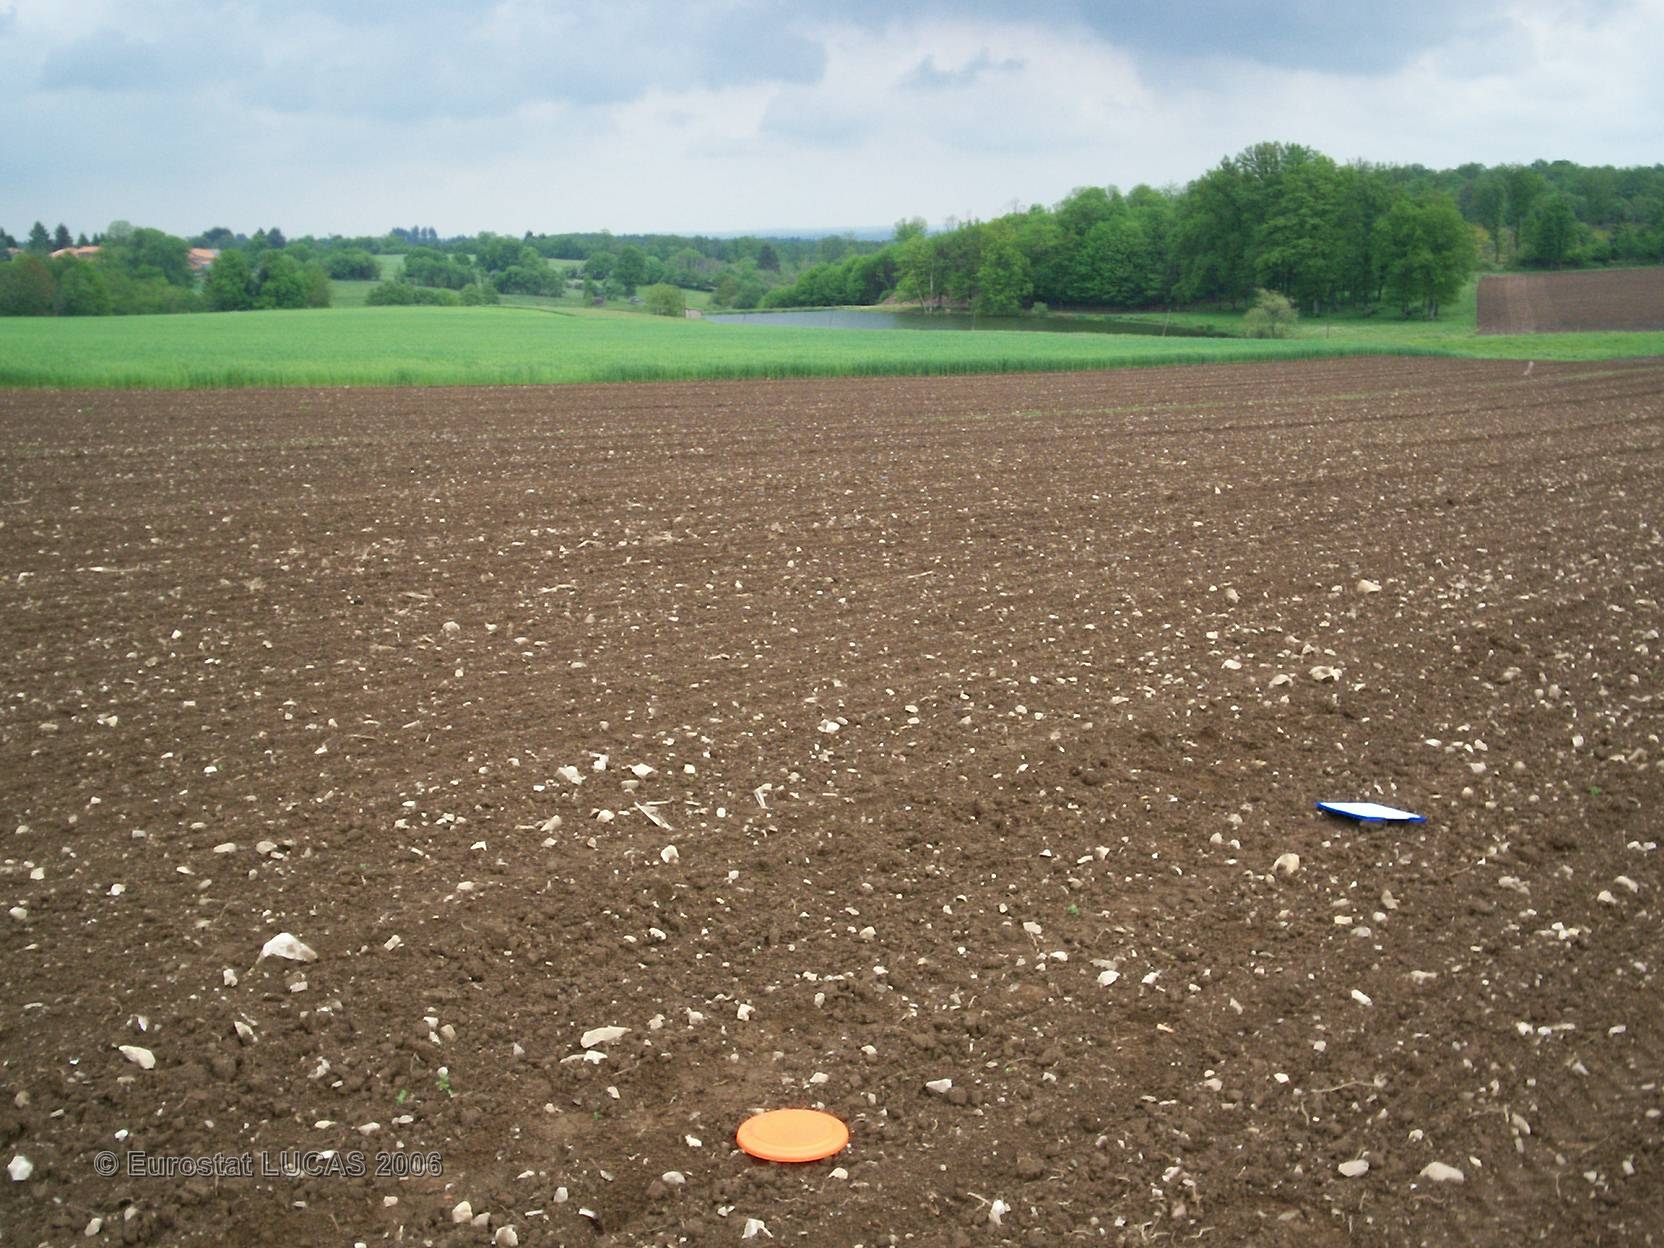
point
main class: Cropland
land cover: Maize
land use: Agriculture (excluding fallow land and kitchen gardens)
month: May
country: FR
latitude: 45.7340
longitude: 0.5667
